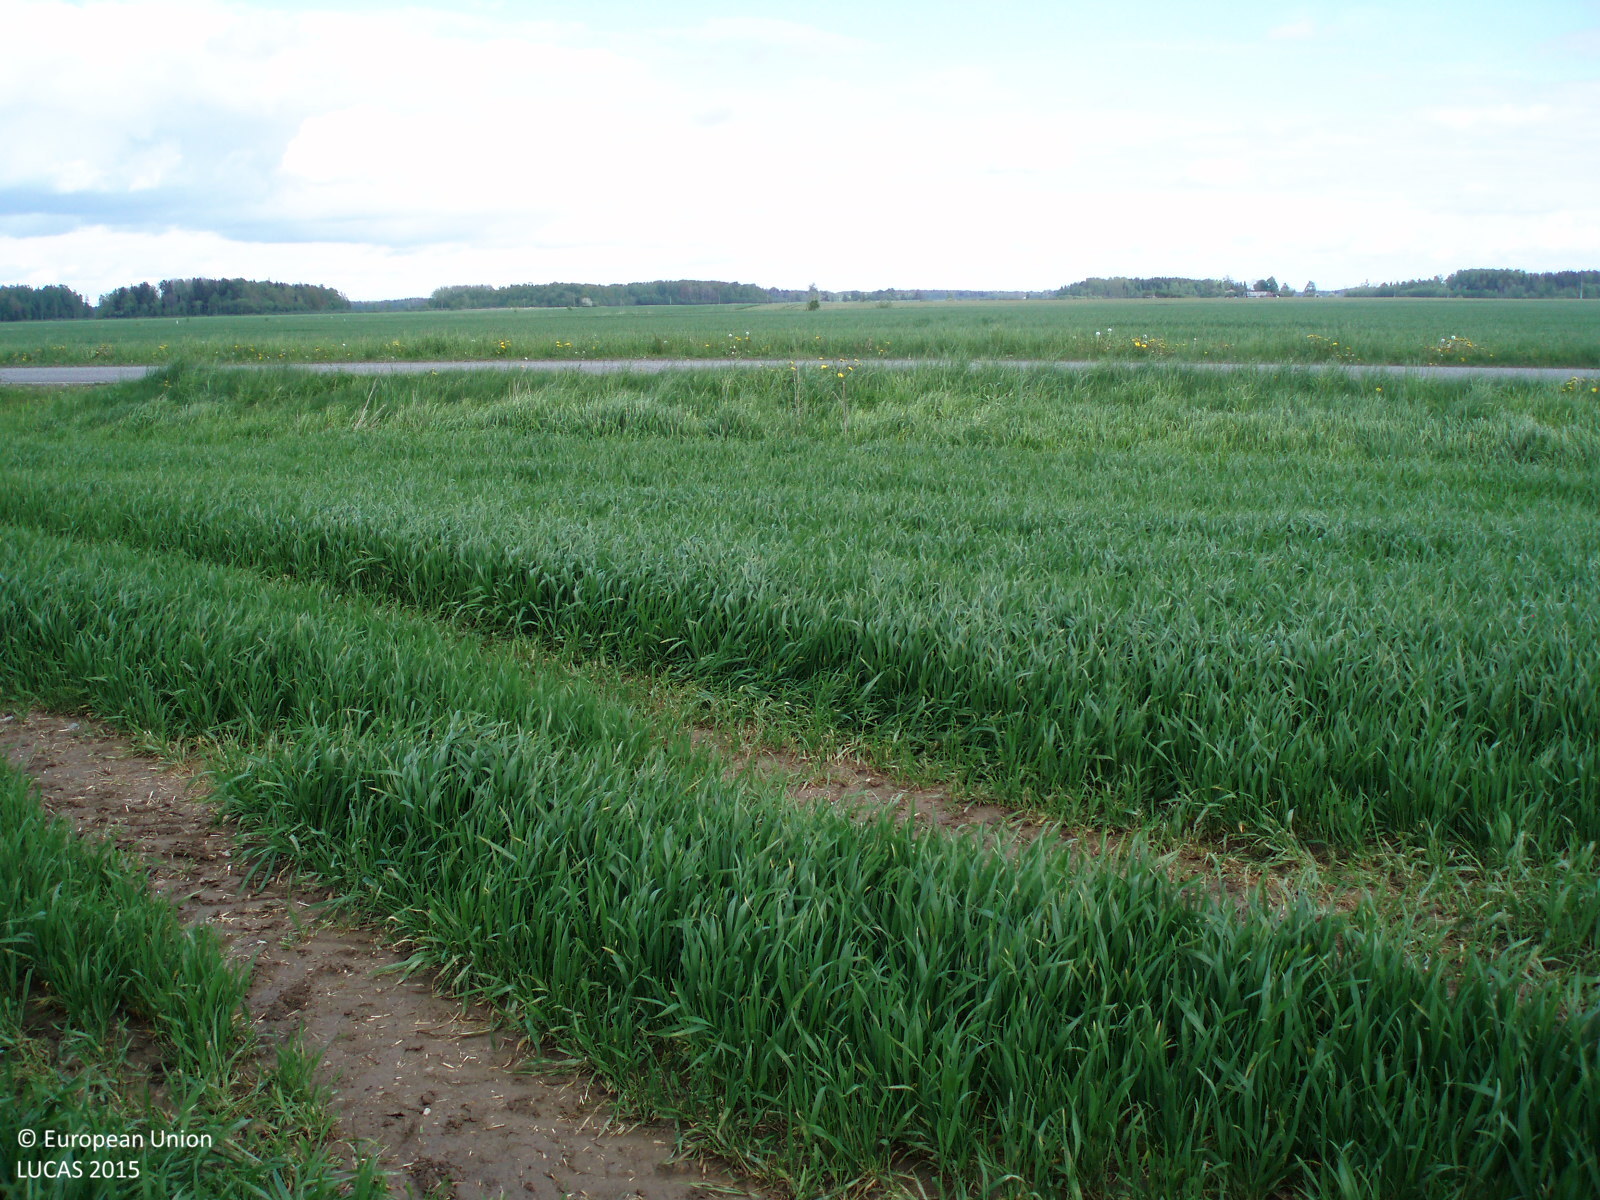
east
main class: Cropland
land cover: Common wheat
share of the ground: > 75 %
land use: Agriculture (excluding fallow land and kitchen gardens)
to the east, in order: Common wheat; Grass margins; Paved roads, cycling and walking lanes; Grass margins; Barley; Grassland with sparse tree/shrub cover; Ditches and canals; Grassland with sparse tree/shrub cover; Barley
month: May
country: LT
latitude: 56.3421
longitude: 22.4659
